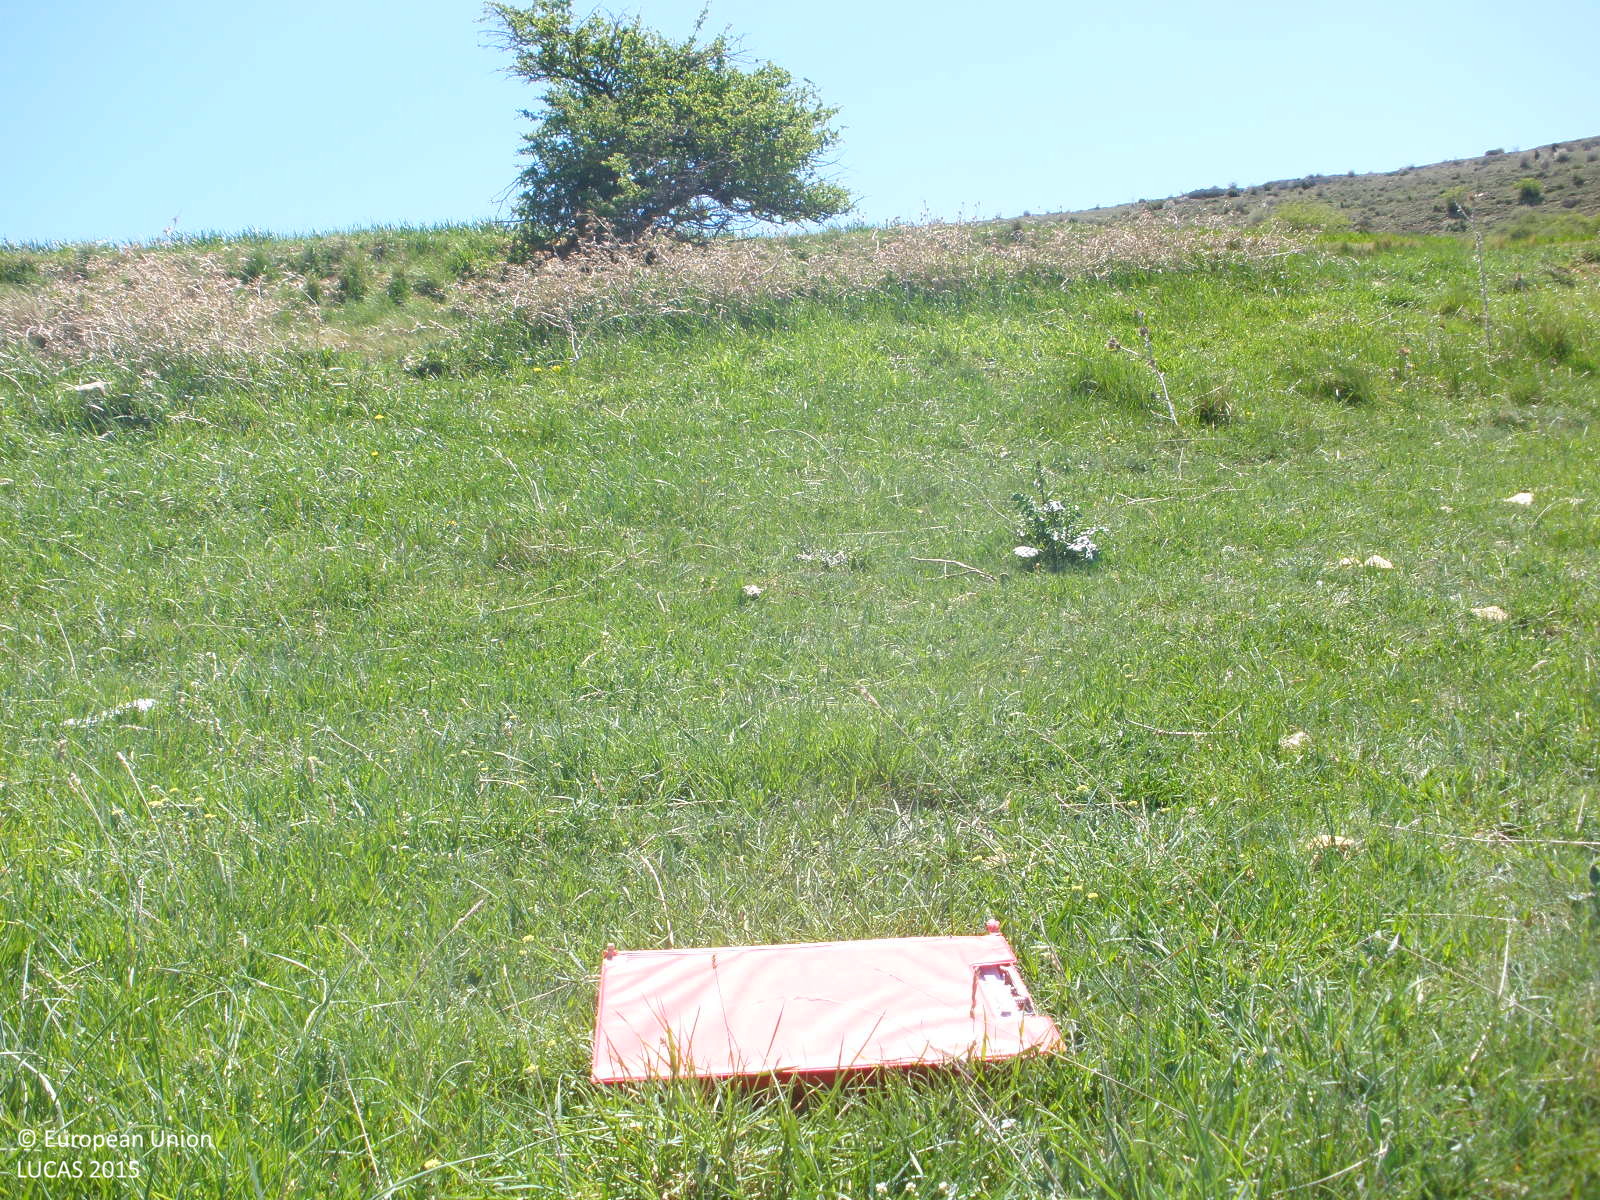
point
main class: Grassland
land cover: Grassland without tree/shrub cover
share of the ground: > 75 %
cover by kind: herbaceous plants 100 %
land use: Semi-natural and natural areas not in use
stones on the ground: < 10 %
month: May
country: ES
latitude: 40.7730
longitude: -0.8780
